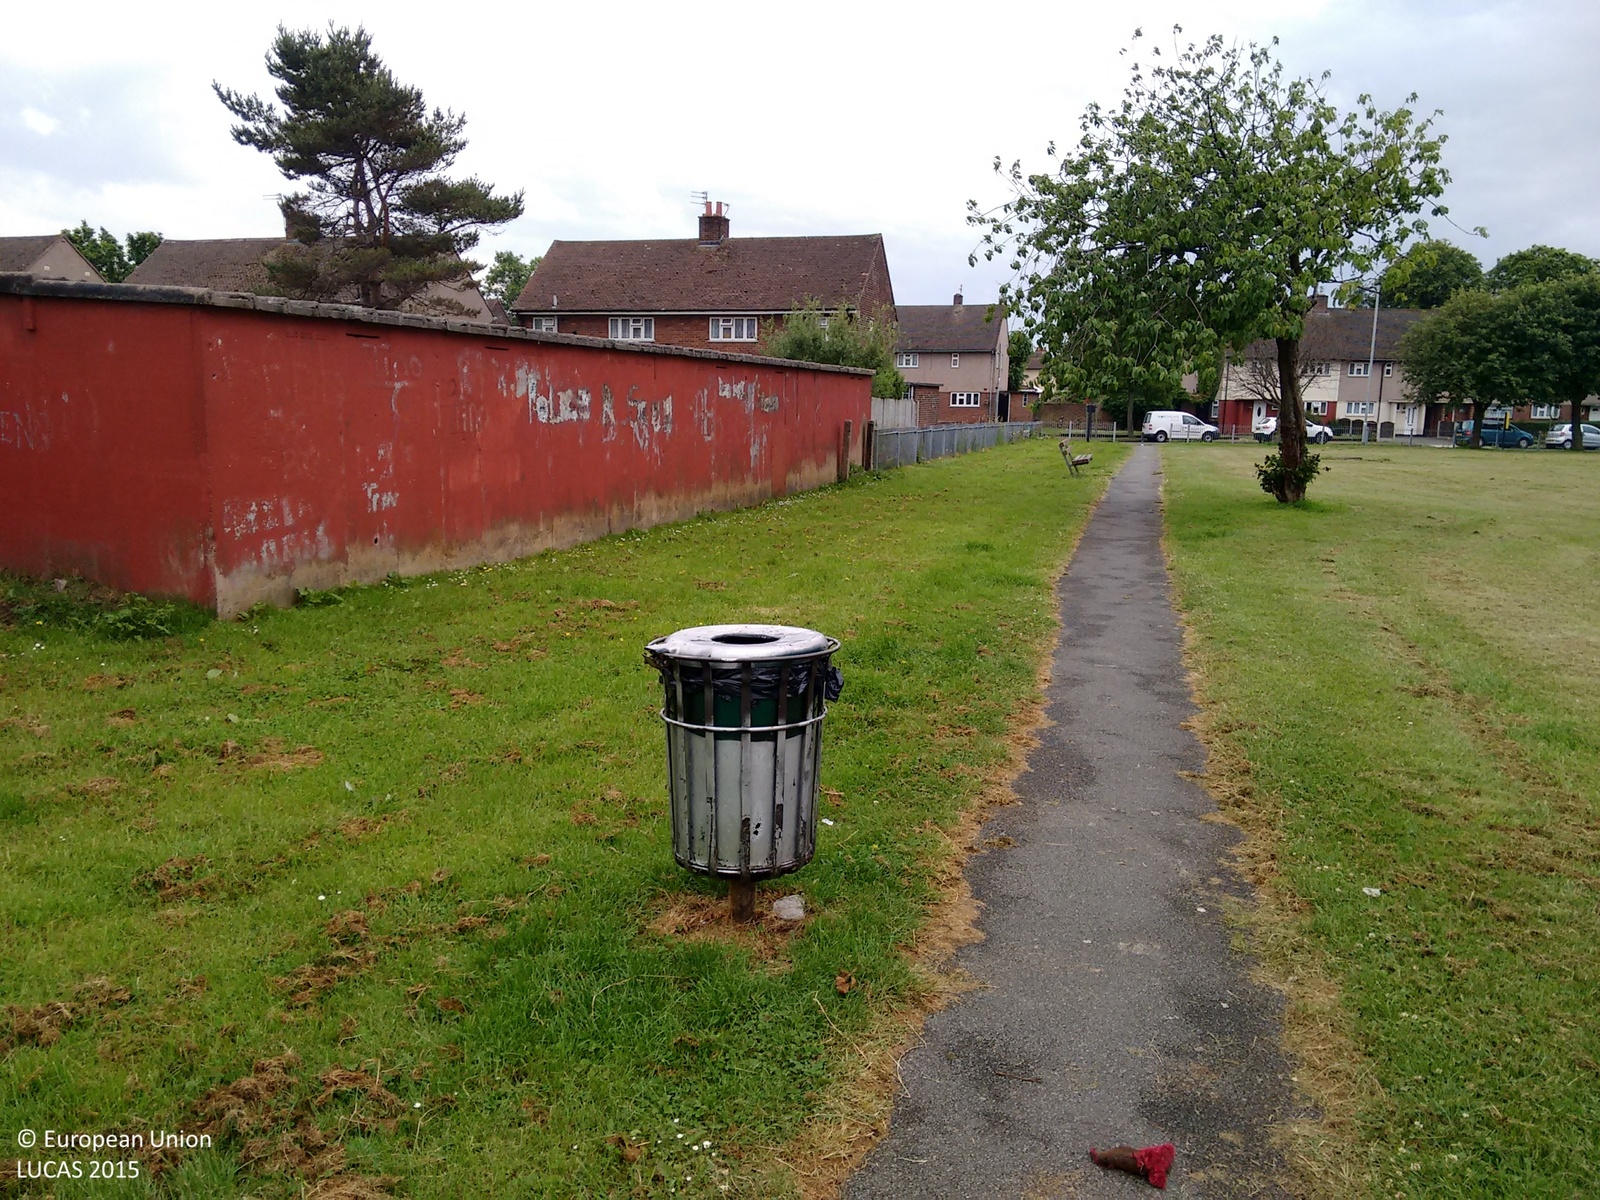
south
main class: Grassland
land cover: Grassland without tree/shrub cover
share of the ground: > 75 %
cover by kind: herbaceous plants 100 %
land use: Amenities, museums, leisure
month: June
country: GB
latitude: 53.4966
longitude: -3.0234
